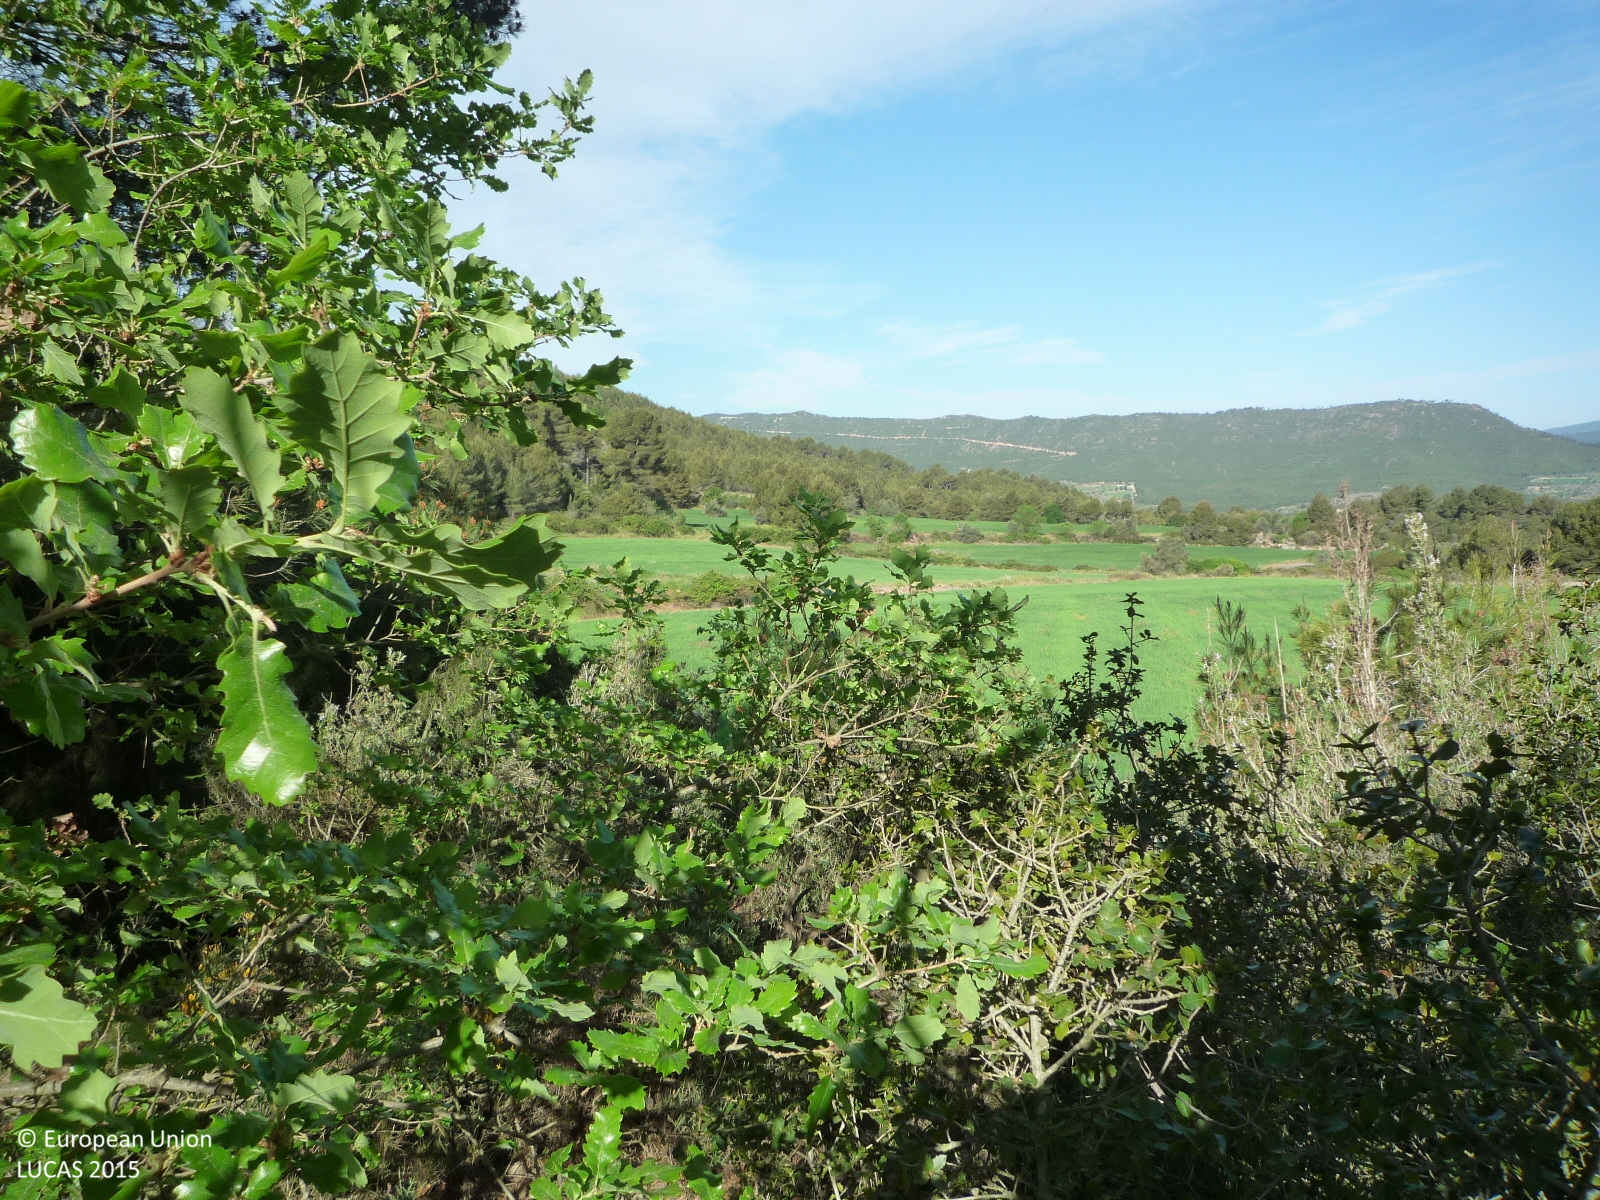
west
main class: Woodland
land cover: Pine dominated mixed woodland
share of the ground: > 75 %
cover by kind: coniferous forest trees 75 %, broadleaved forest trees 25 %
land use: Semi-natural and natural areas not in use
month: April
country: ES
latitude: 41.7147
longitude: 1.7096
